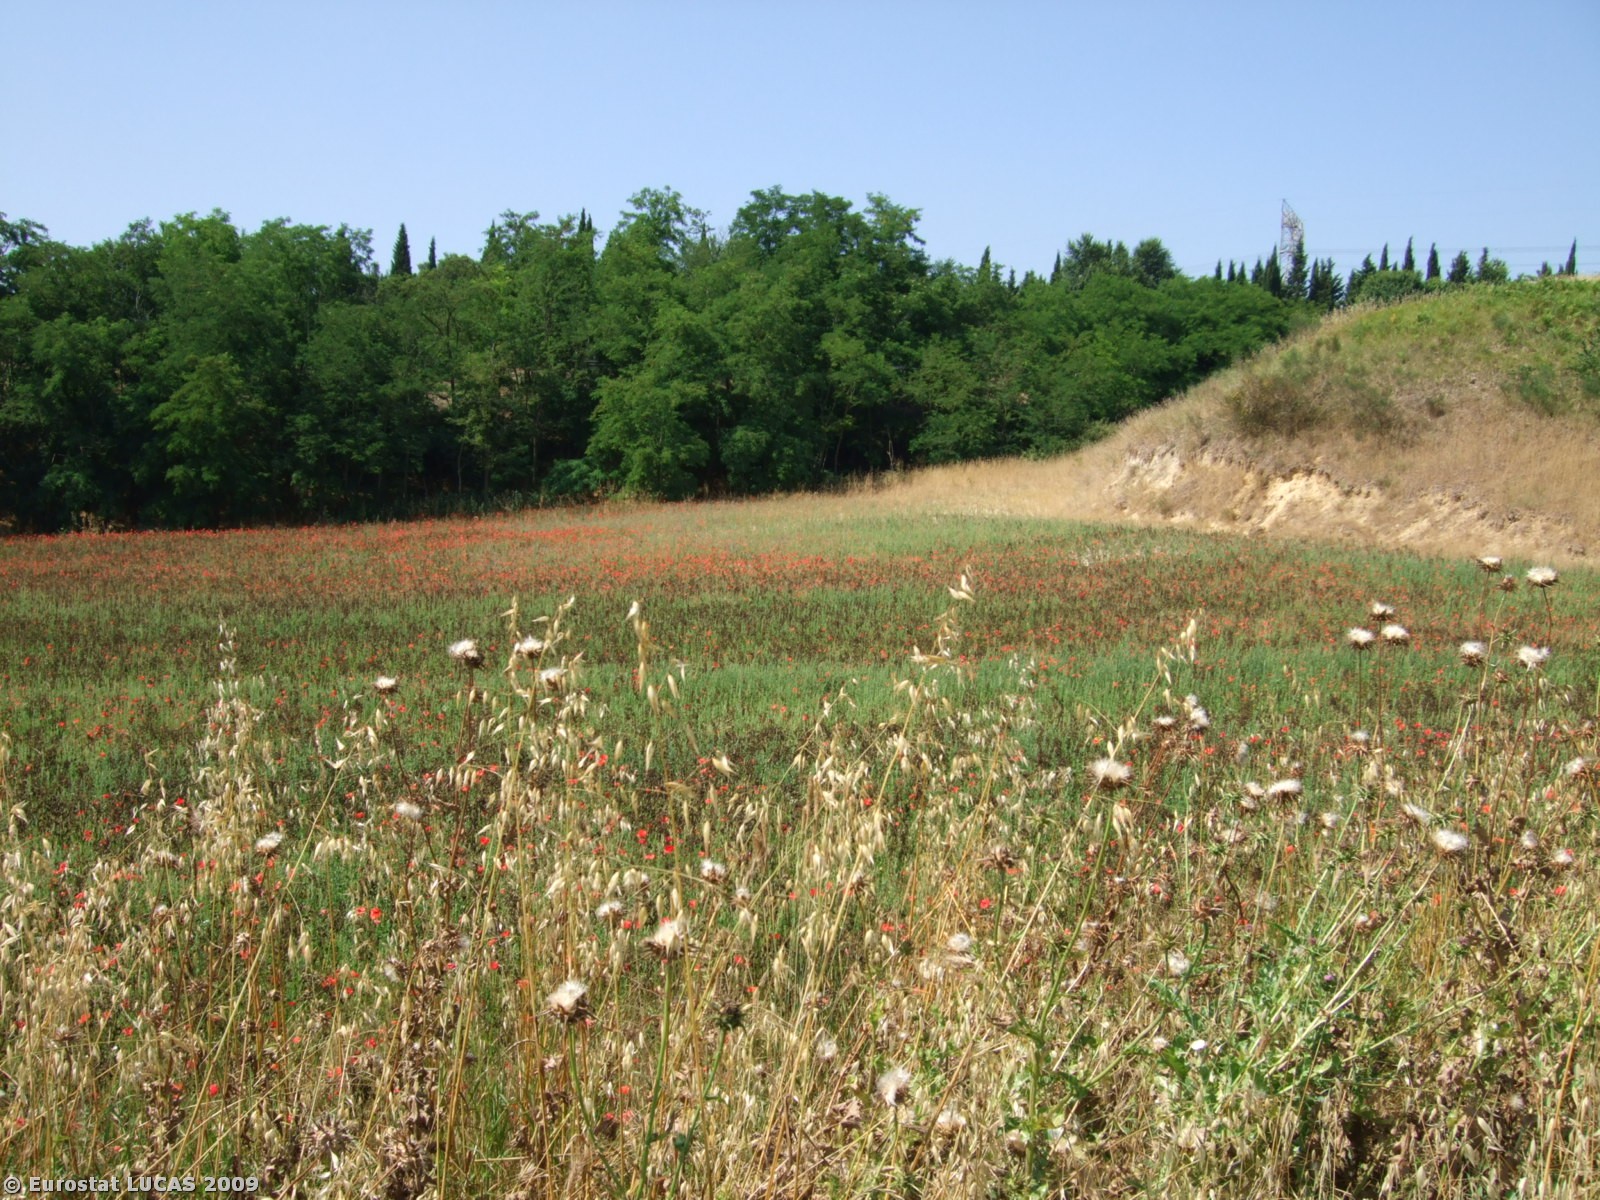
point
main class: Cropland
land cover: Dry pulses
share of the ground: > 75 %
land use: Agriculture (excluding fallow land and kitchen gardens)
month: June
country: IT
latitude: 41.8865
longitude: 12.3172
